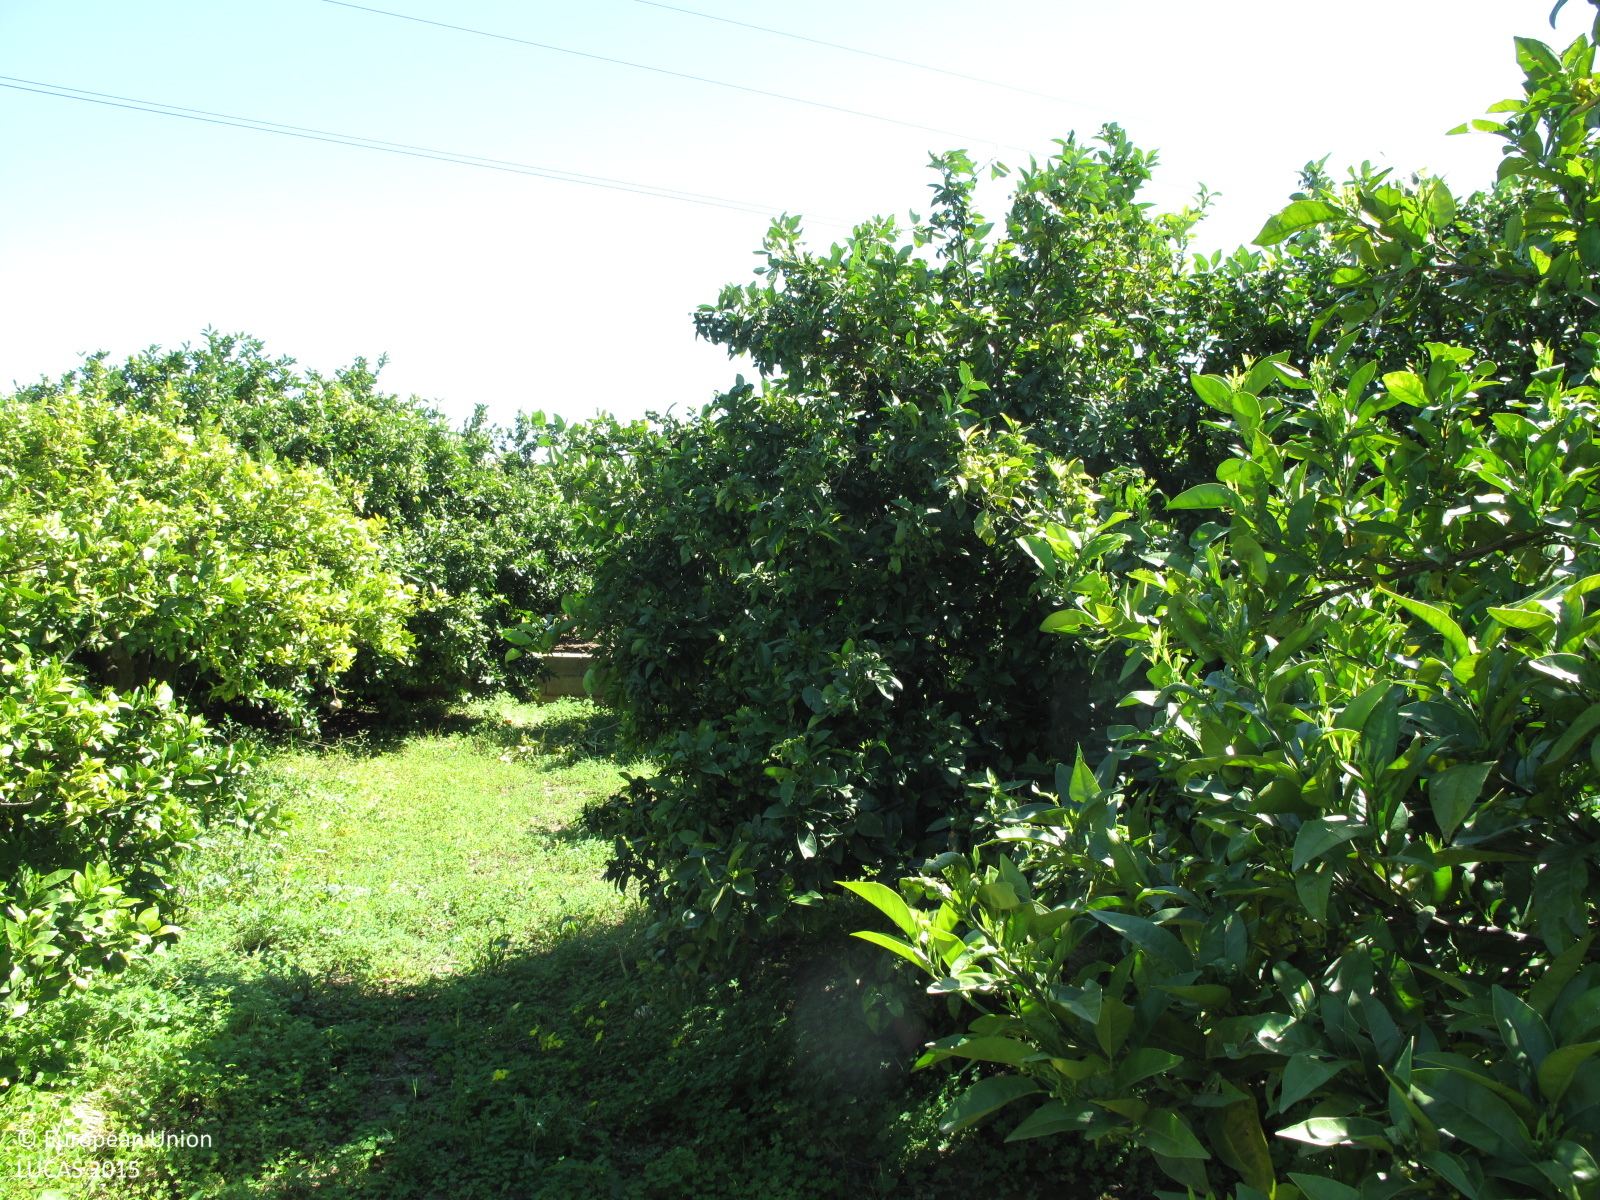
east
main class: Artificial land
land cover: Other artificial areas
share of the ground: < 10 %
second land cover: Oranges
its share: > 75 %
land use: Electricity, gas and thermal power distribution
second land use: Agriculture (excluding fallow land and kitchen gardens)
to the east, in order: Artificial constructions in urban areas; Oranges; Dry stone walls; Oranges; Grass margins; Ditches and canals; Grass margins; Oranges; Artificial constructions in urban areas
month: March
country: ES
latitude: 39.1153
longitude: -0.5303
